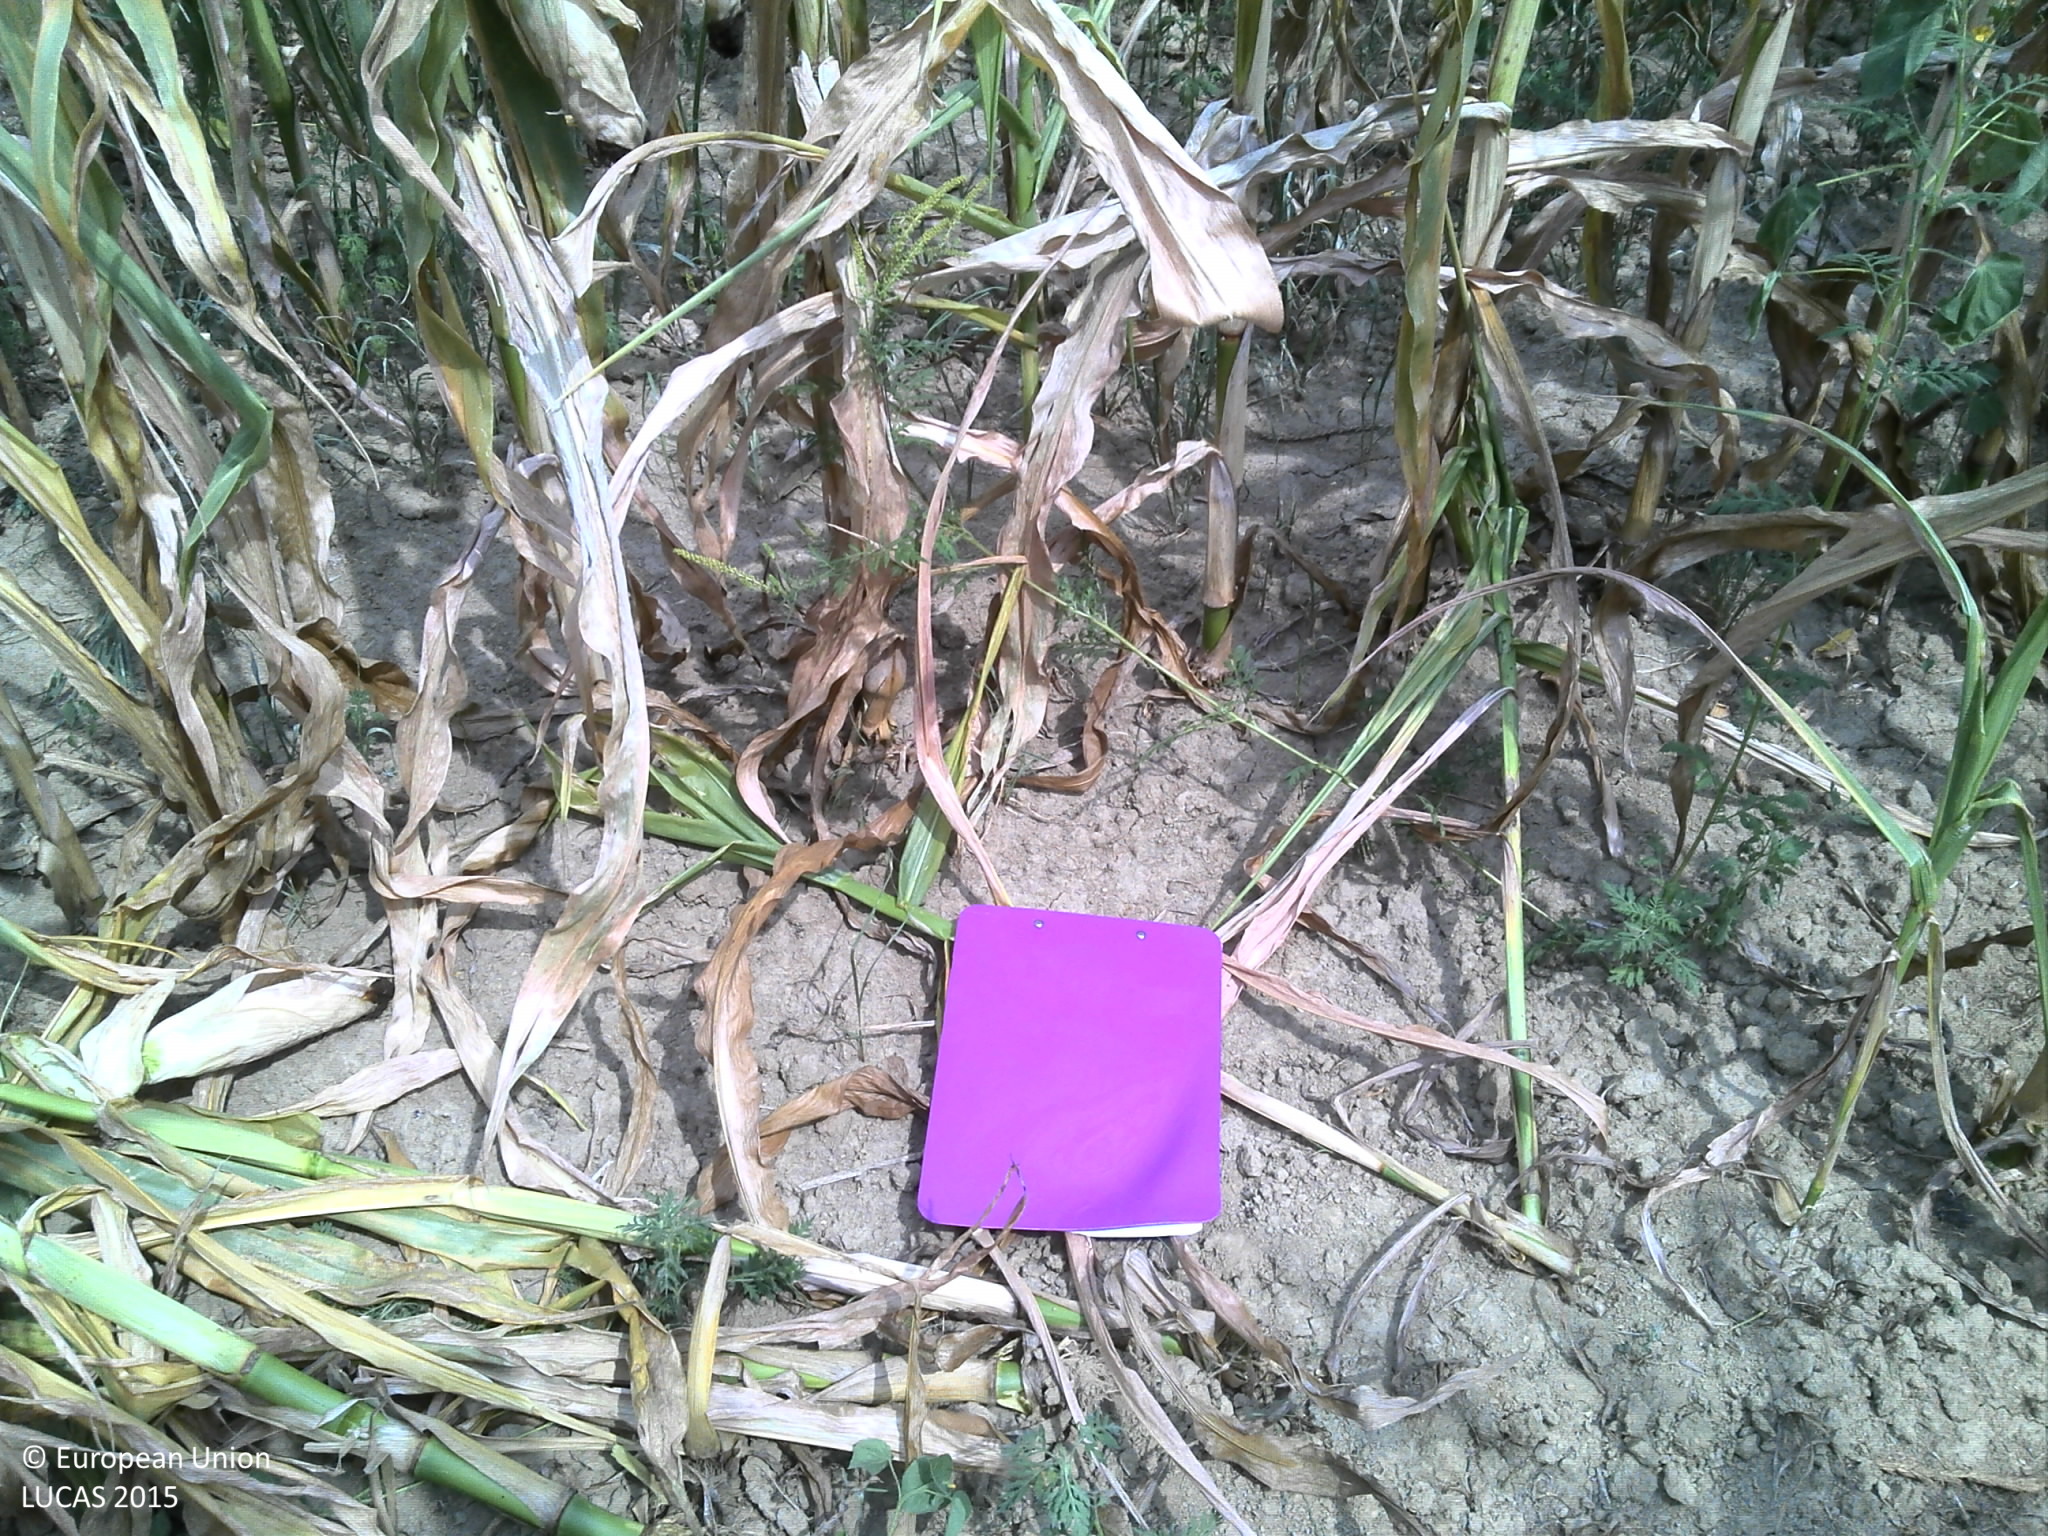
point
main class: Cropland
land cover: Maize
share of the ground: > 75 %
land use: Agriculture (excluding fallow land and kitchen gardens)
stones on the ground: < 10 %
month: August
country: HR
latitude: 45.4145
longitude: 18.5036
